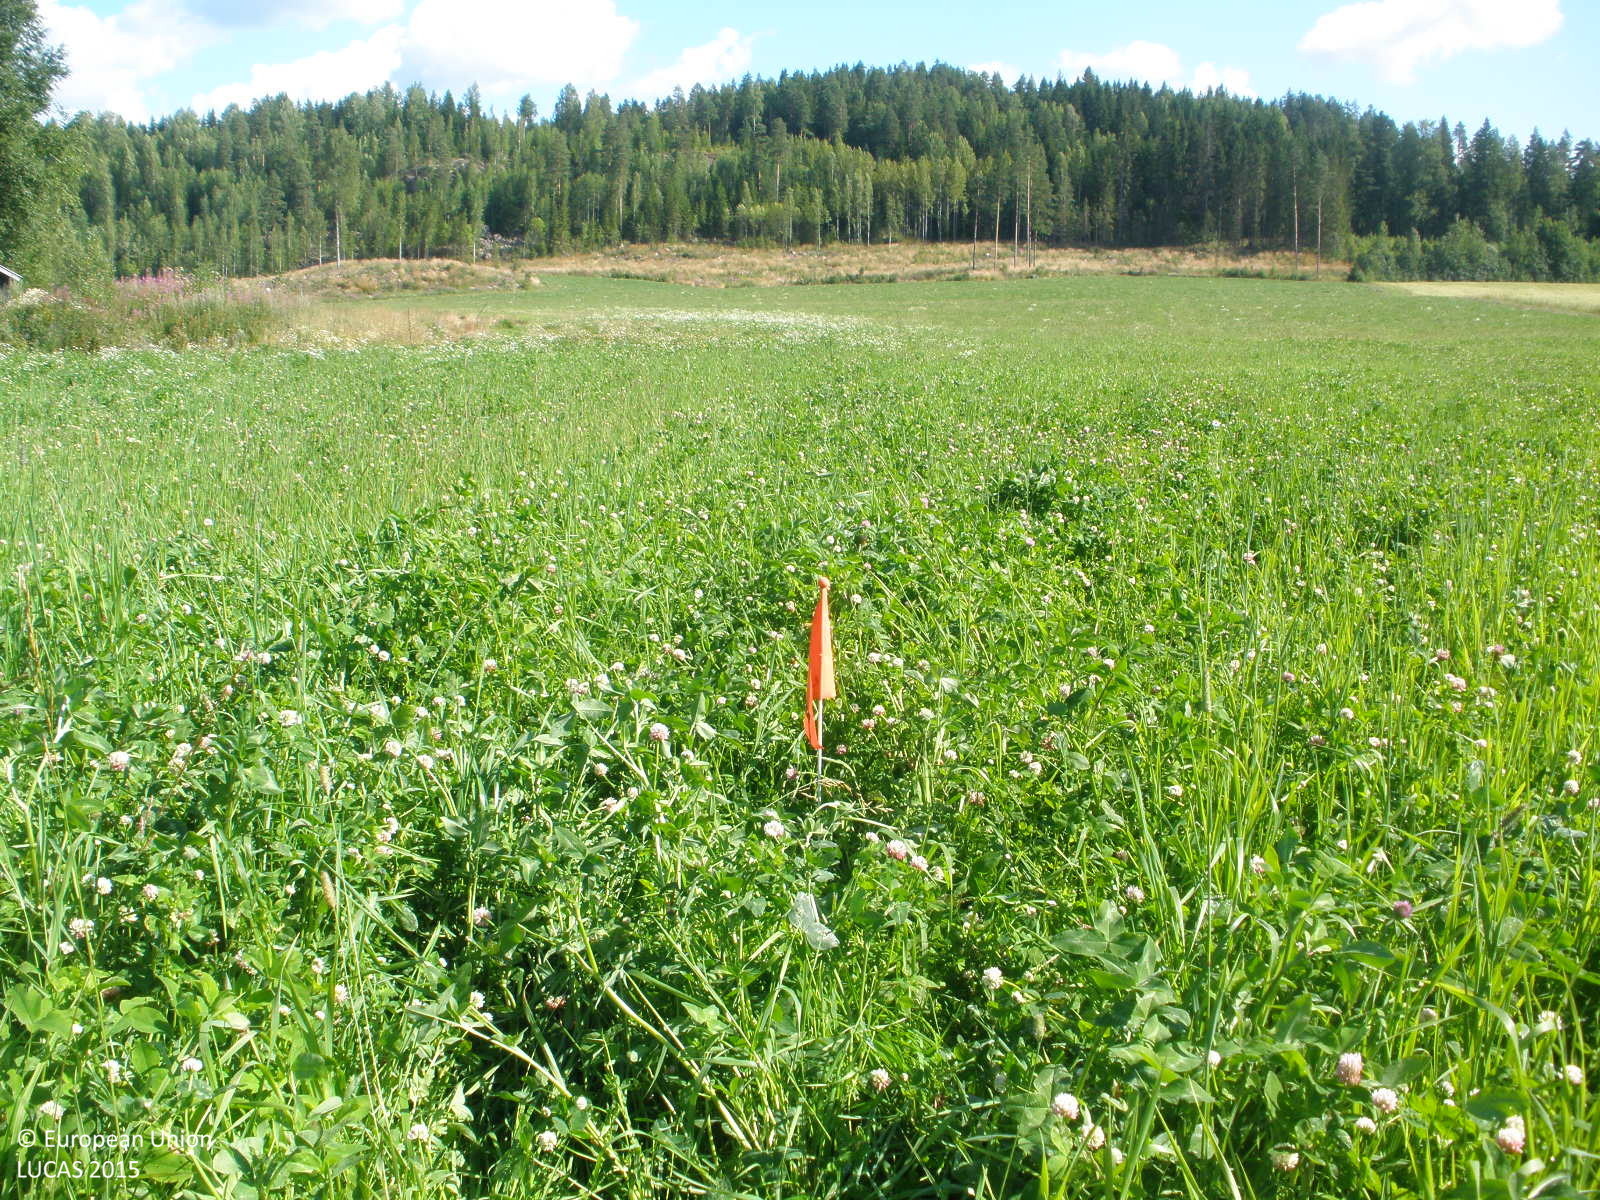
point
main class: Cropland
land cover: Other leguminous and mixtures for fodder
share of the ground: > 75 %
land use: Agriculture (excluding fallow land and kitchen gardens)
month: August
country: FI
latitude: 60.9551
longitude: 24.9775
